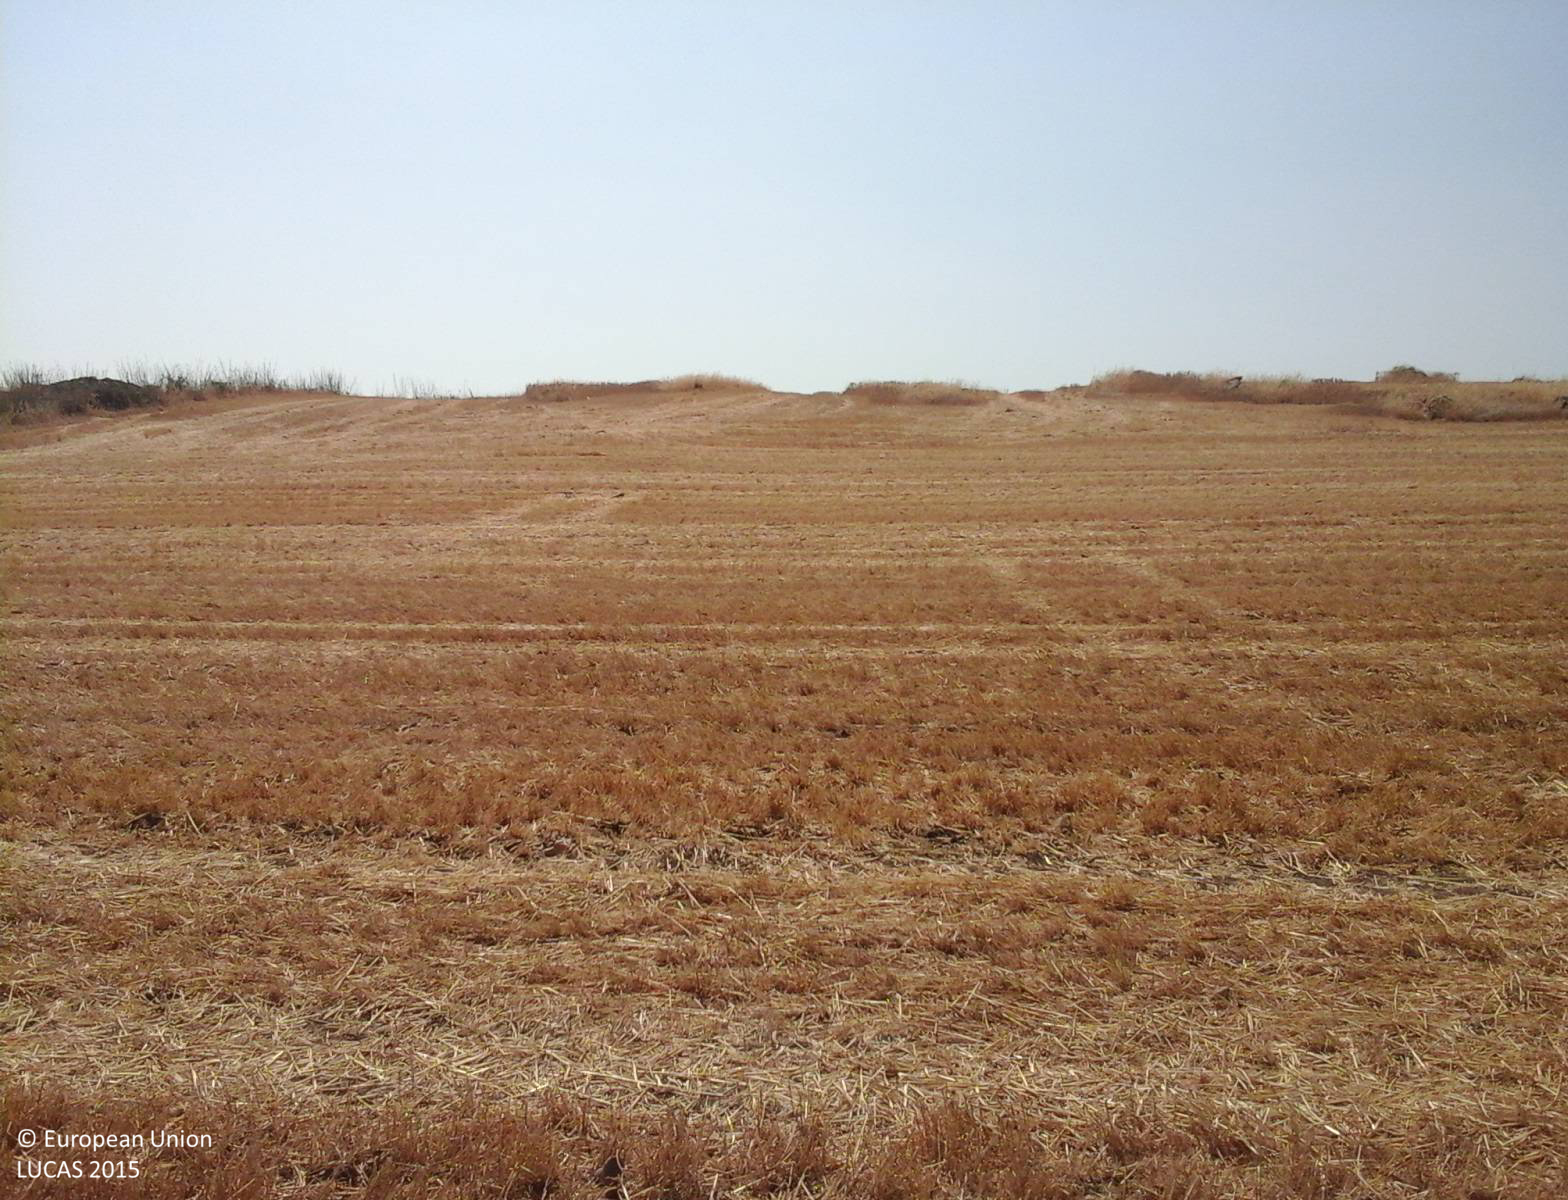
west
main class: Cropland
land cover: Barley
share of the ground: < 10 %
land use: Agriculture (excluding fallow land and kitchen gardens)
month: July
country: IT
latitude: 39.7168
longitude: 8.8053
